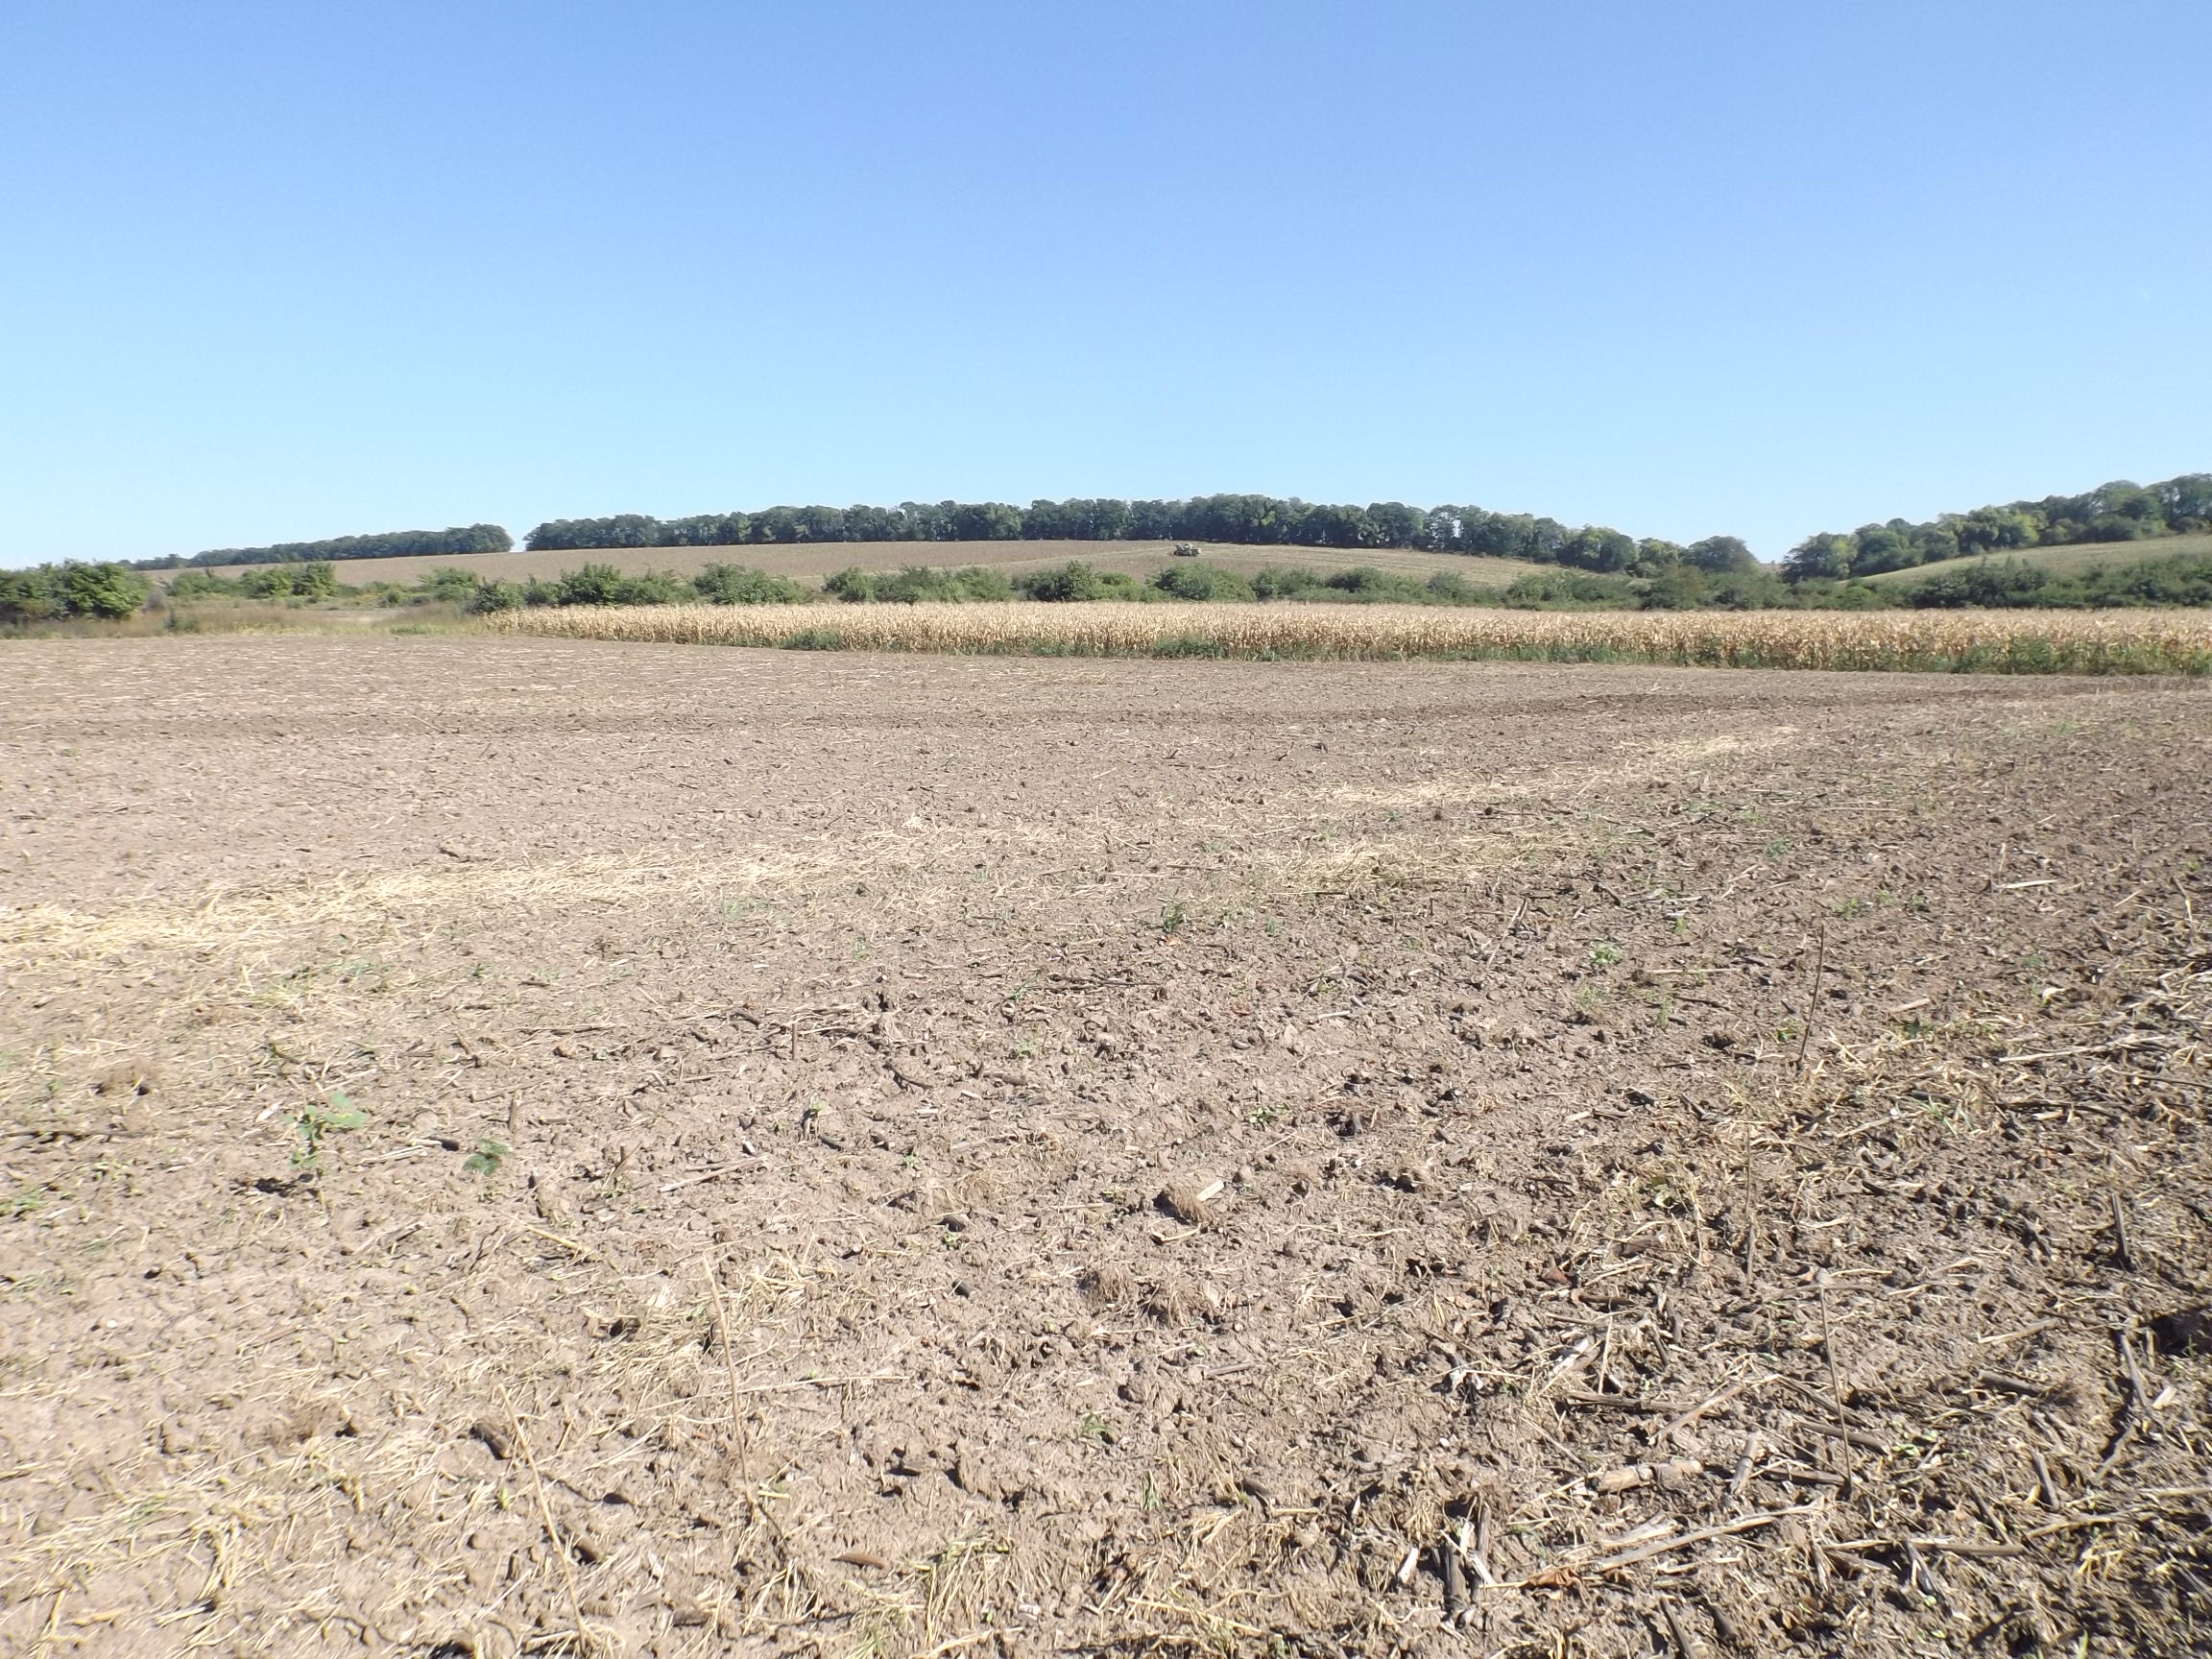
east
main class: Cropland
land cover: Sunflower
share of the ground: < 10 %
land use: Agriculture (excluding fallow land and kitchen gardens)
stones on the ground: < 10 %
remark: Harvested field
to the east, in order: Sunflower; Grass margins; Maize; Grass margins; Other fresh vegetables; Grass margins; Broadleaved woodland; Tracks; Common wheat; Ditches and canals; Broadleaved woodland; Grass margins; Tracks; Grass margins; Sunflower
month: September
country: BG
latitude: 43.9916
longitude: 26.5073
